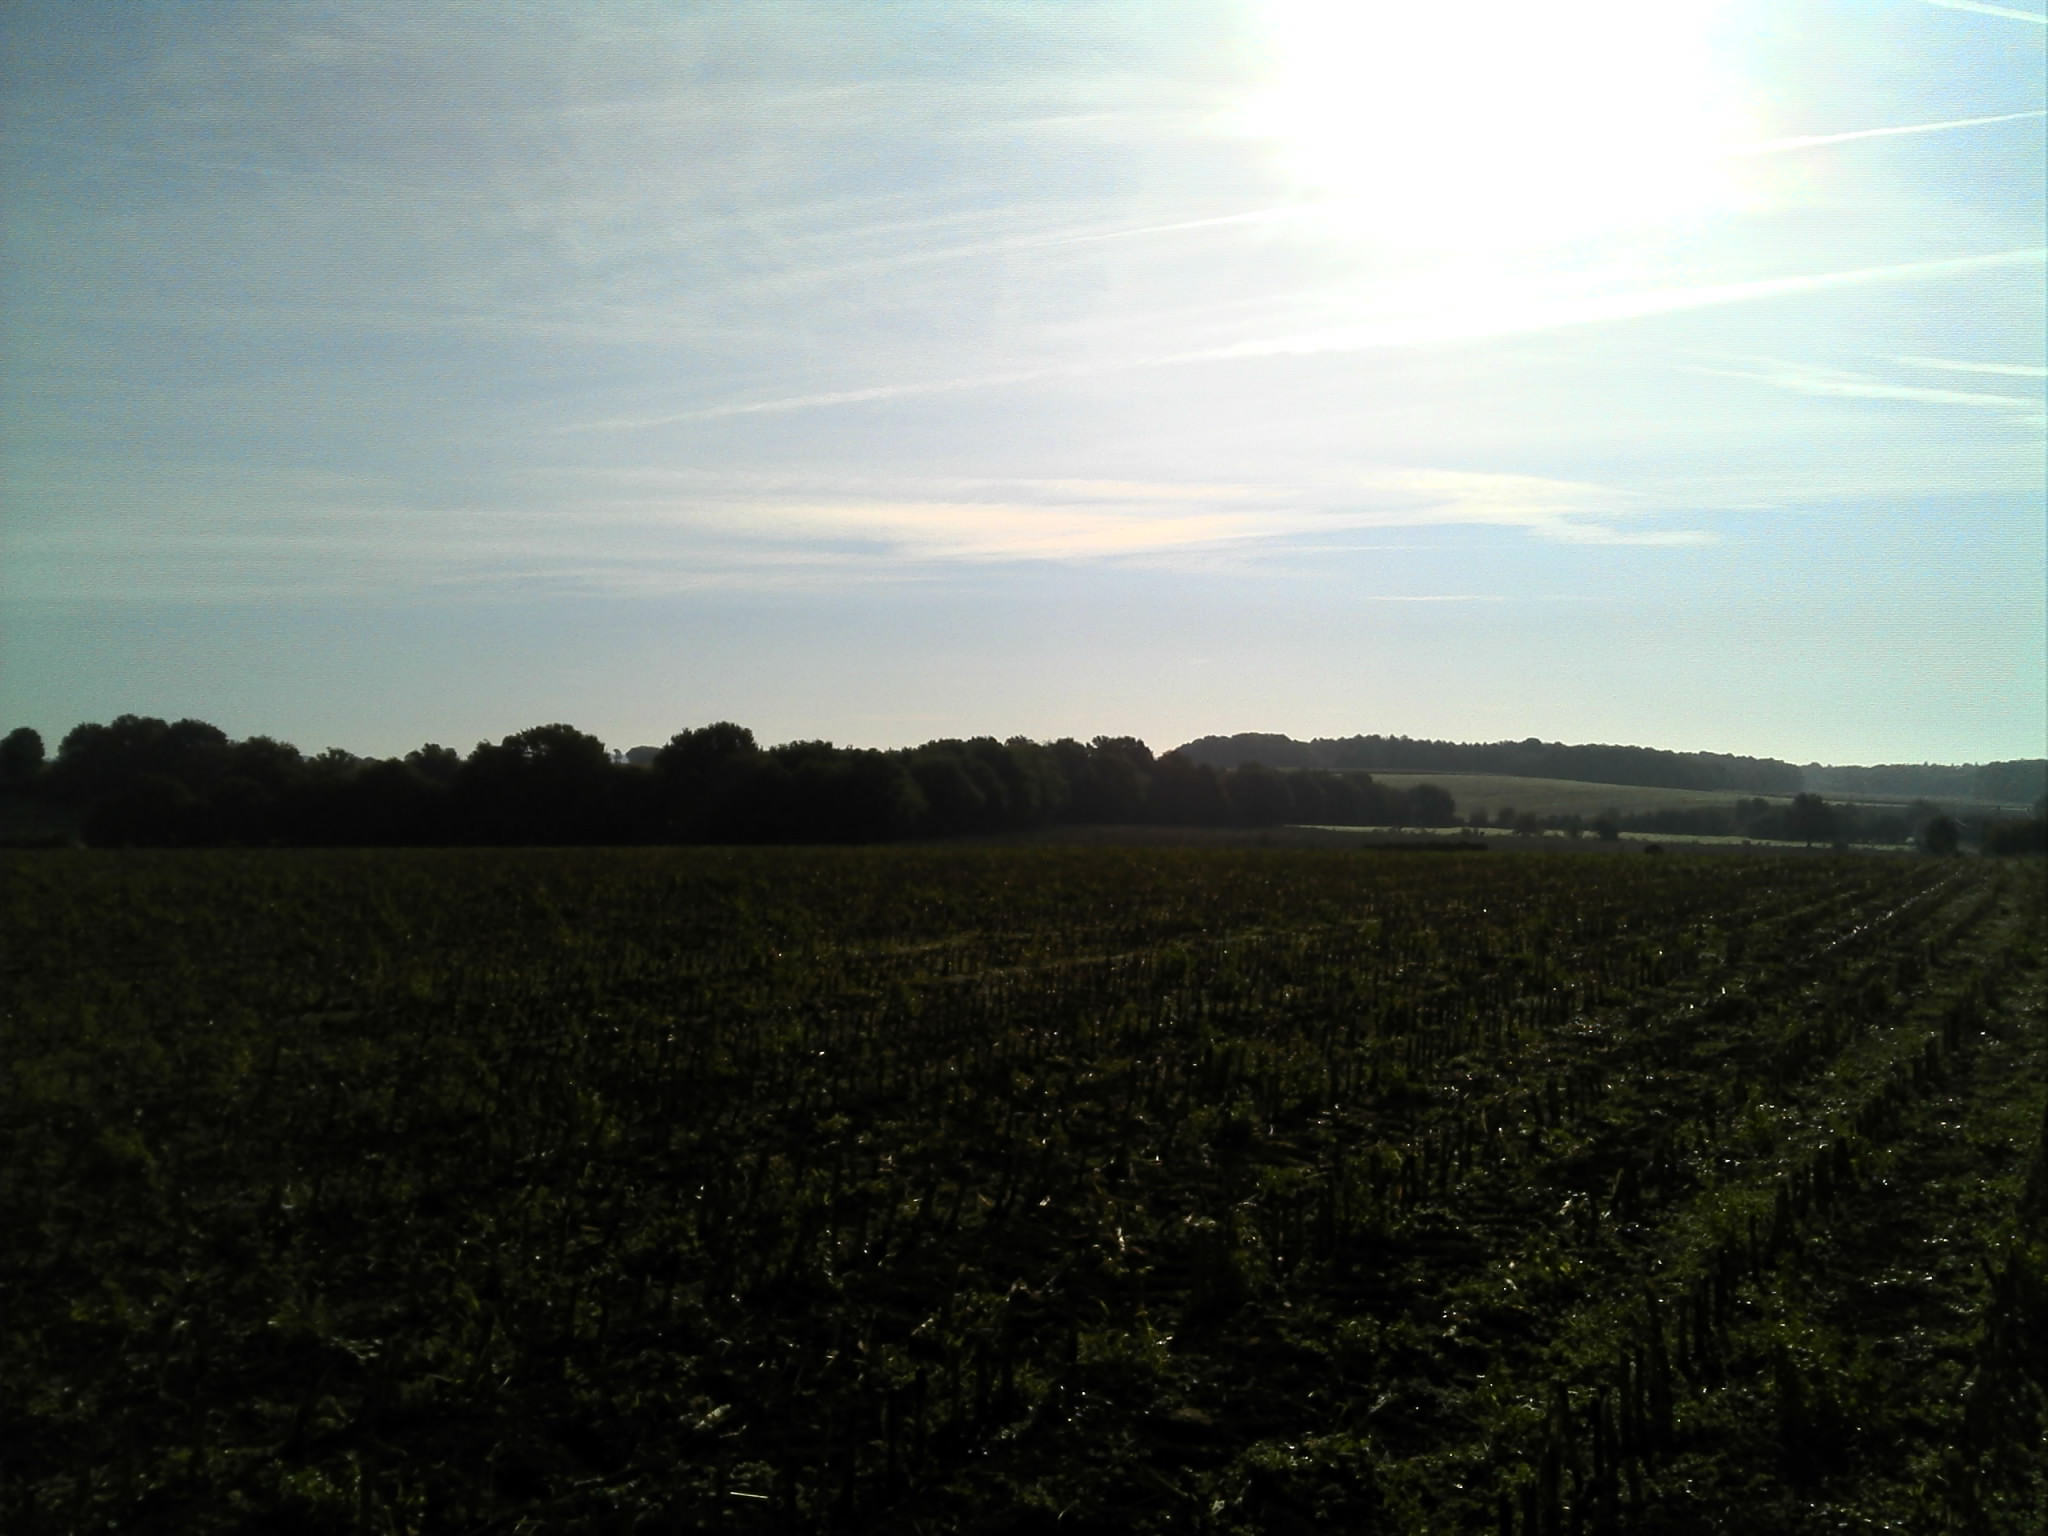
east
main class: Cropland
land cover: Maize
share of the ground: < 10 %
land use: Agriculture (excluding fallow land and kitchen gardens)
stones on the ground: 10 - 25 %
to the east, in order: Maize
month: September
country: FR
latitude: 48.0898
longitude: 0.5654
